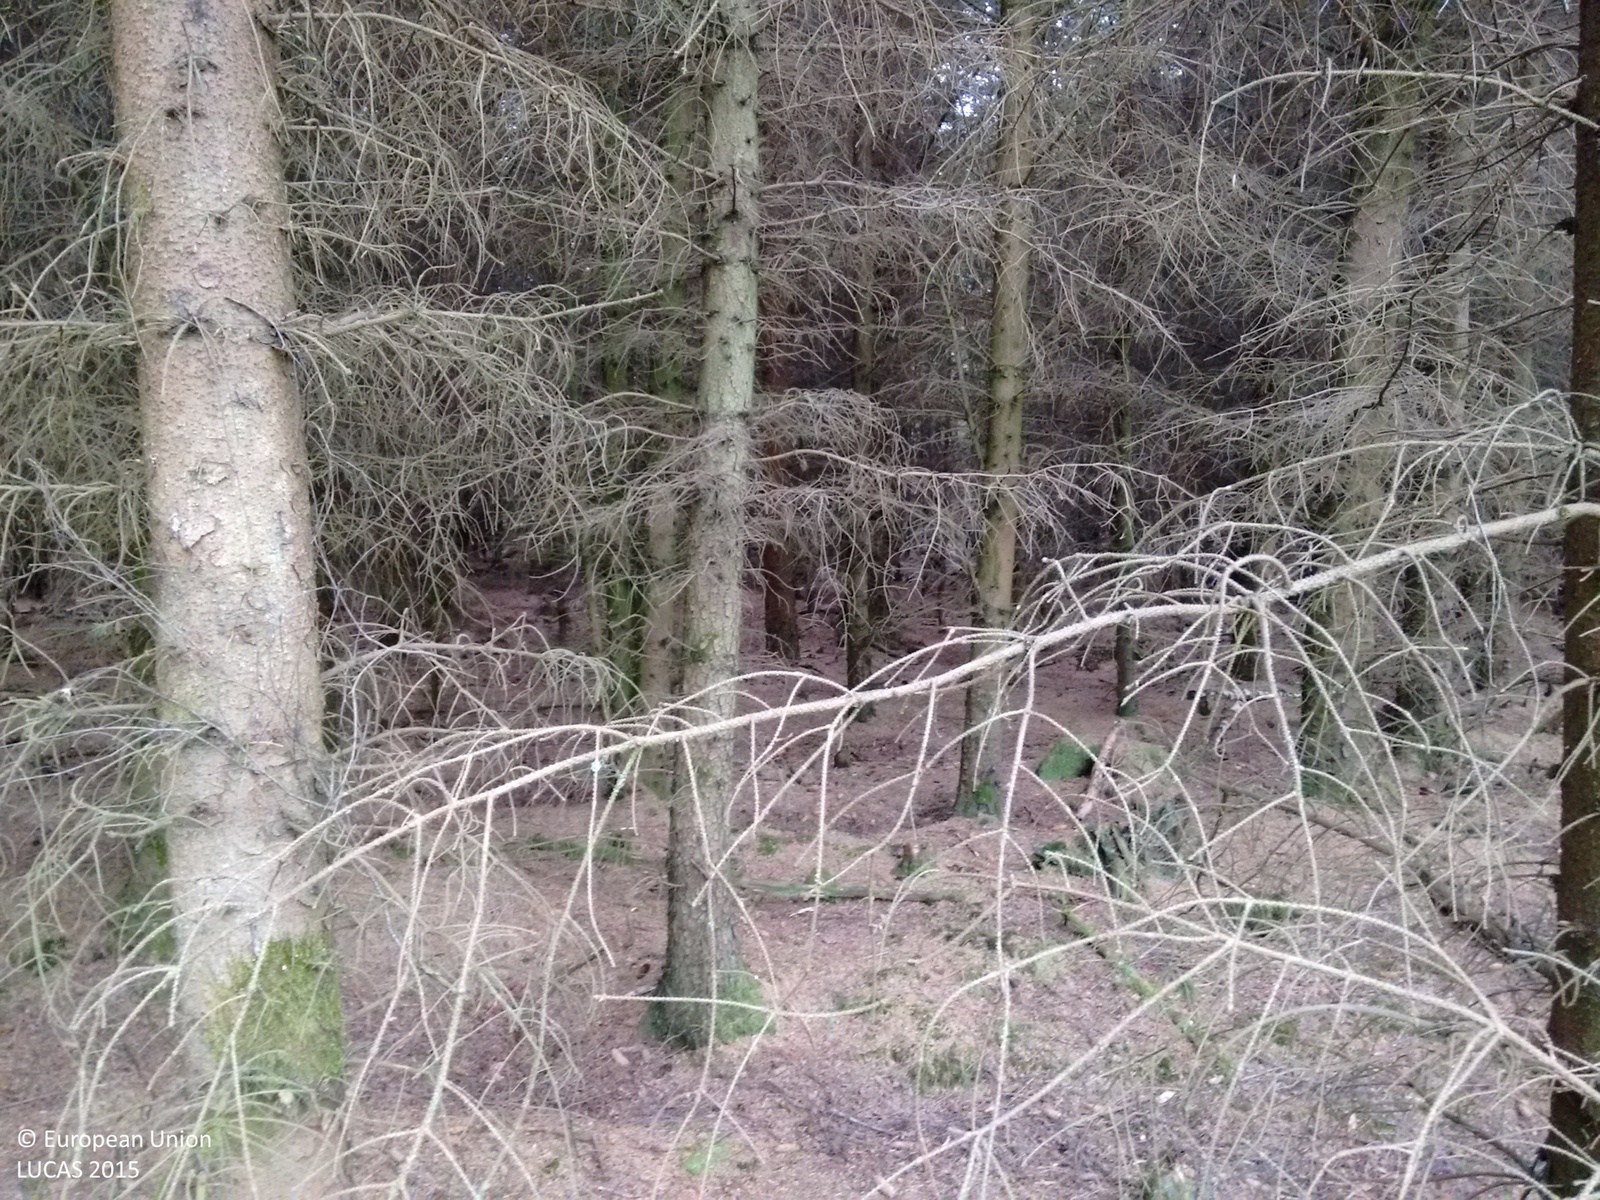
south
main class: Woodland
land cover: Spruce dominated coniferous woodland
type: exotic forest
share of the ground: > 75 %
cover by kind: coniferous forest trees 80 %, broadleaved forest trees 10 %, herbaceous plants 5 %, lichens and mosses 5 %
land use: Forestry
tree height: > 5 m
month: June
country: GB
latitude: 56.8043
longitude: -2.5856
